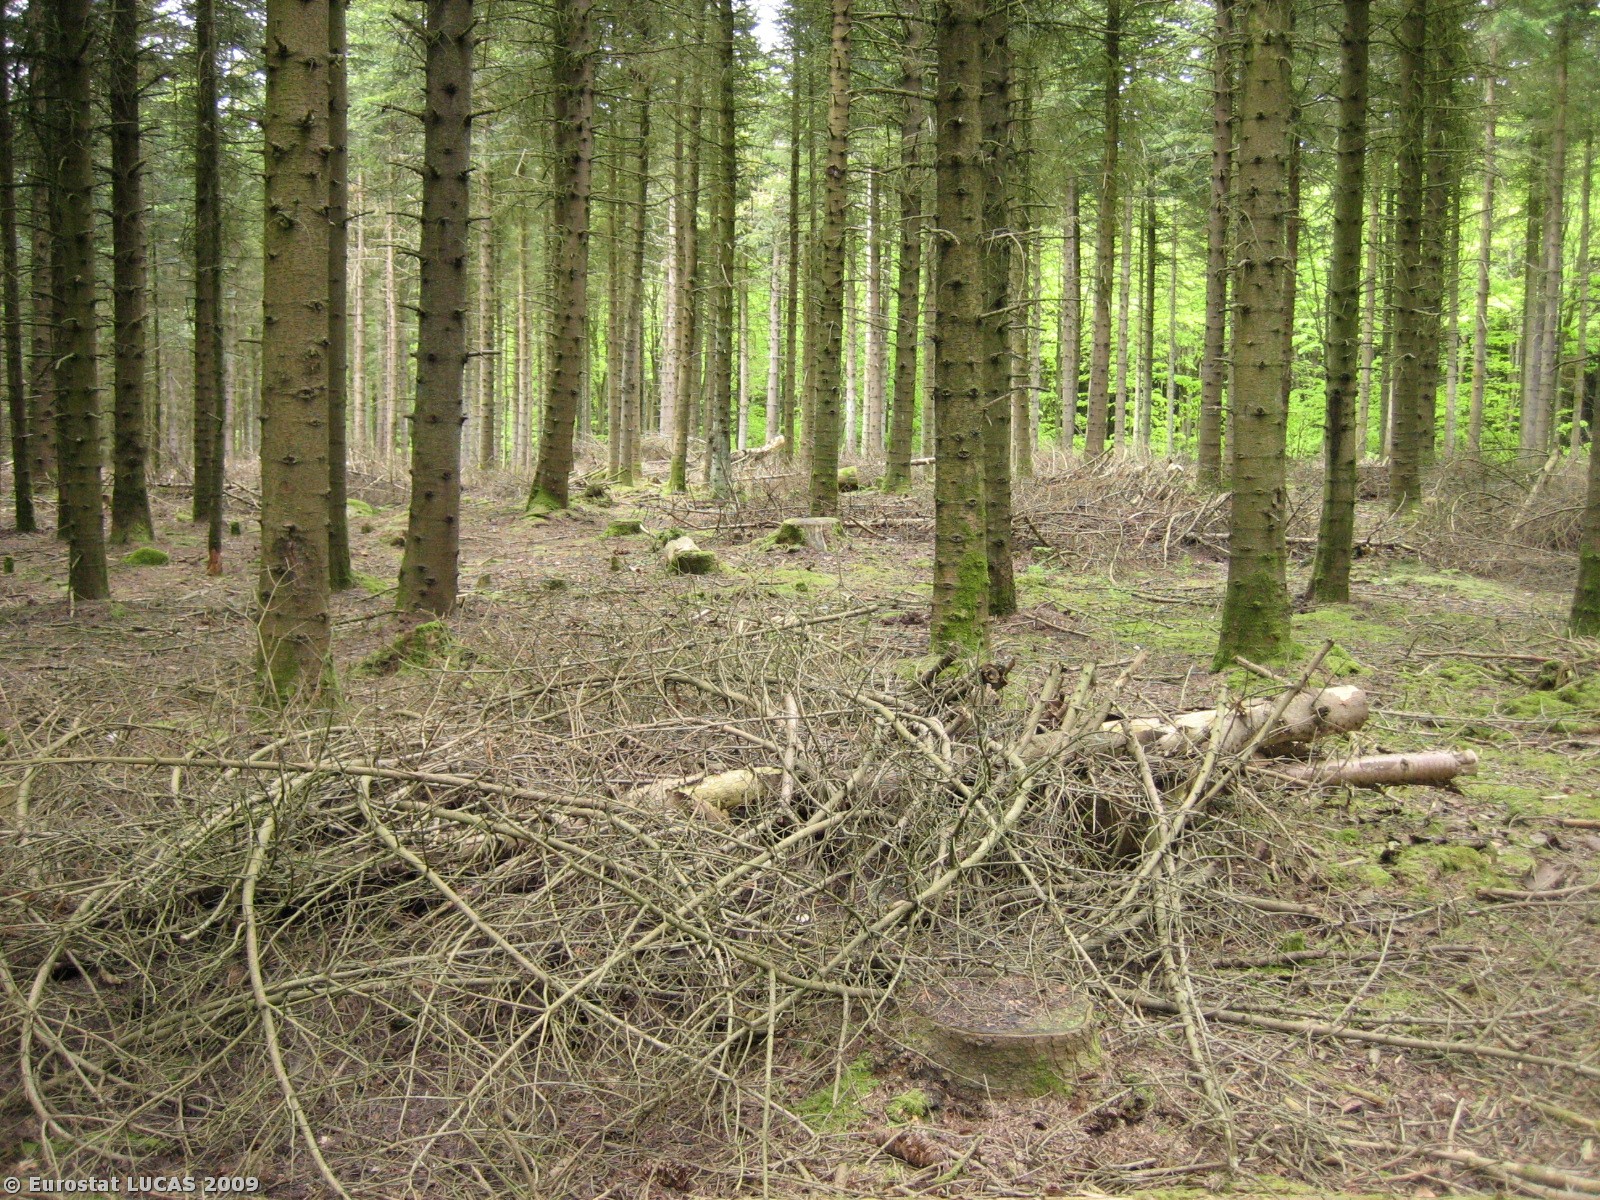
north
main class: Woodland
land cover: Coniferous woodland
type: hemiboreal forest and nemoral coniferous forest and mixed broadleaved-coniferous forest
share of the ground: > 75 %
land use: Forestry
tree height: > 5 m
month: May
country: DK
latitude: 56.1599
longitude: 8.4077
